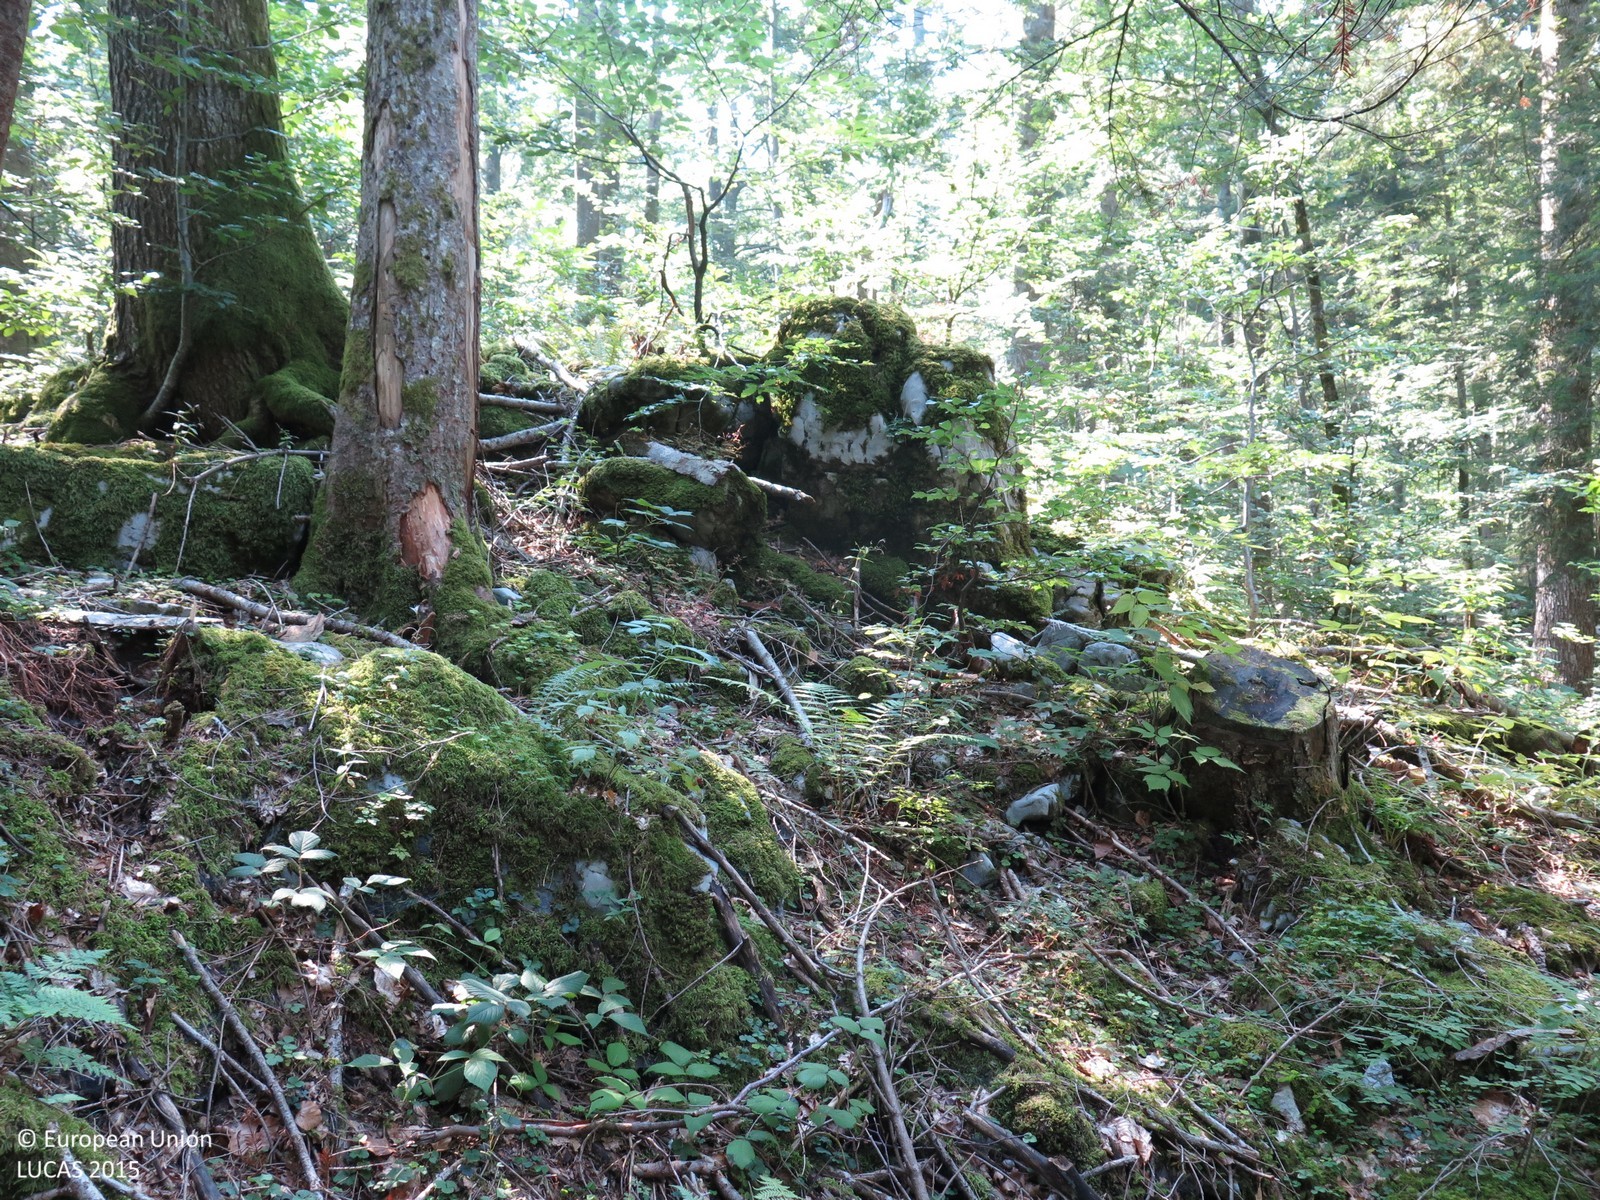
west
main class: Woodland
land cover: Other mixed woodland
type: mountainous beech forest
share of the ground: > 75 %
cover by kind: coniferous forest trees 75 %, broadleaved forest trees 25 %
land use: Forestry
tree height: > 5 m
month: August
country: HR
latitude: 45.5309
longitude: 14.5923
